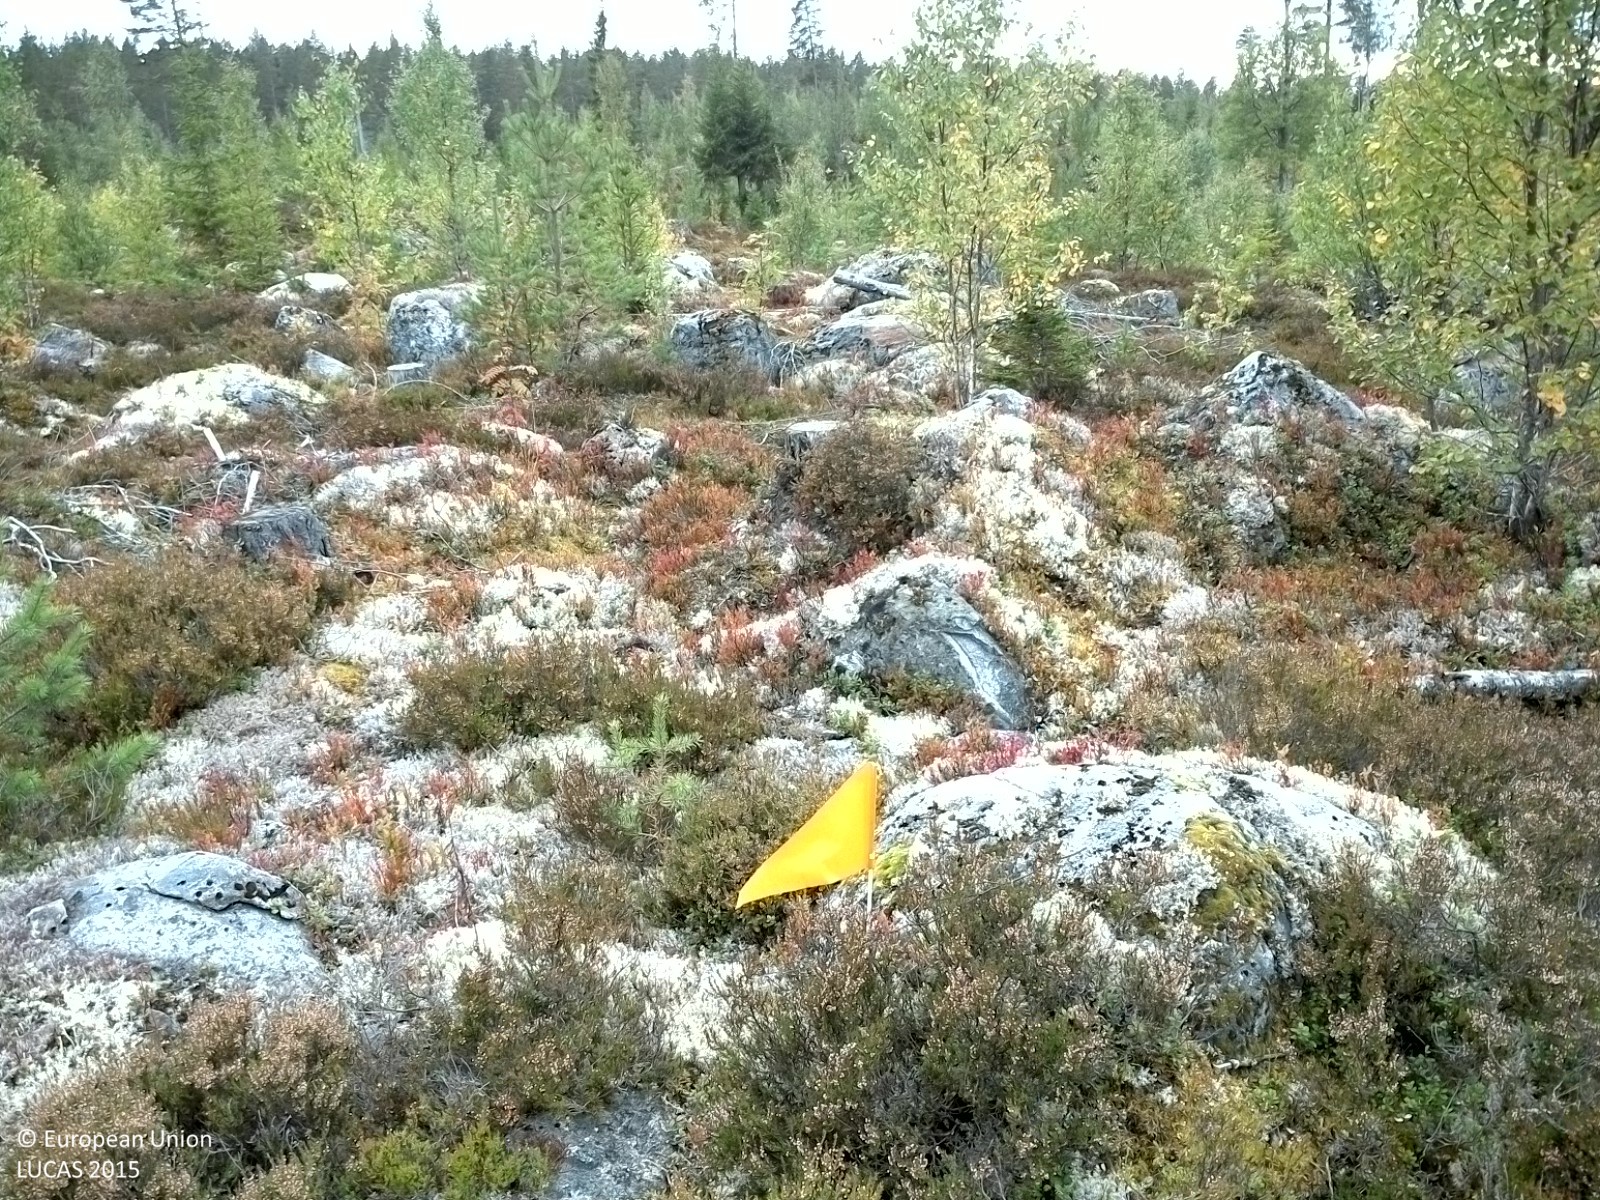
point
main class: Woodland
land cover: Other mixed woodland
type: boreal forest
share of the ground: 10 - 25 %
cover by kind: shrubs 60 %, consolidated bare surface 20 %, lichens and mosses 10 %, coniferous forest trees 5 %, broadleaved forest trees 5 %
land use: Forestry
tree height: < 5 m
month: September
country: SE
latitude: 62.3276
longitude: 15.5971
